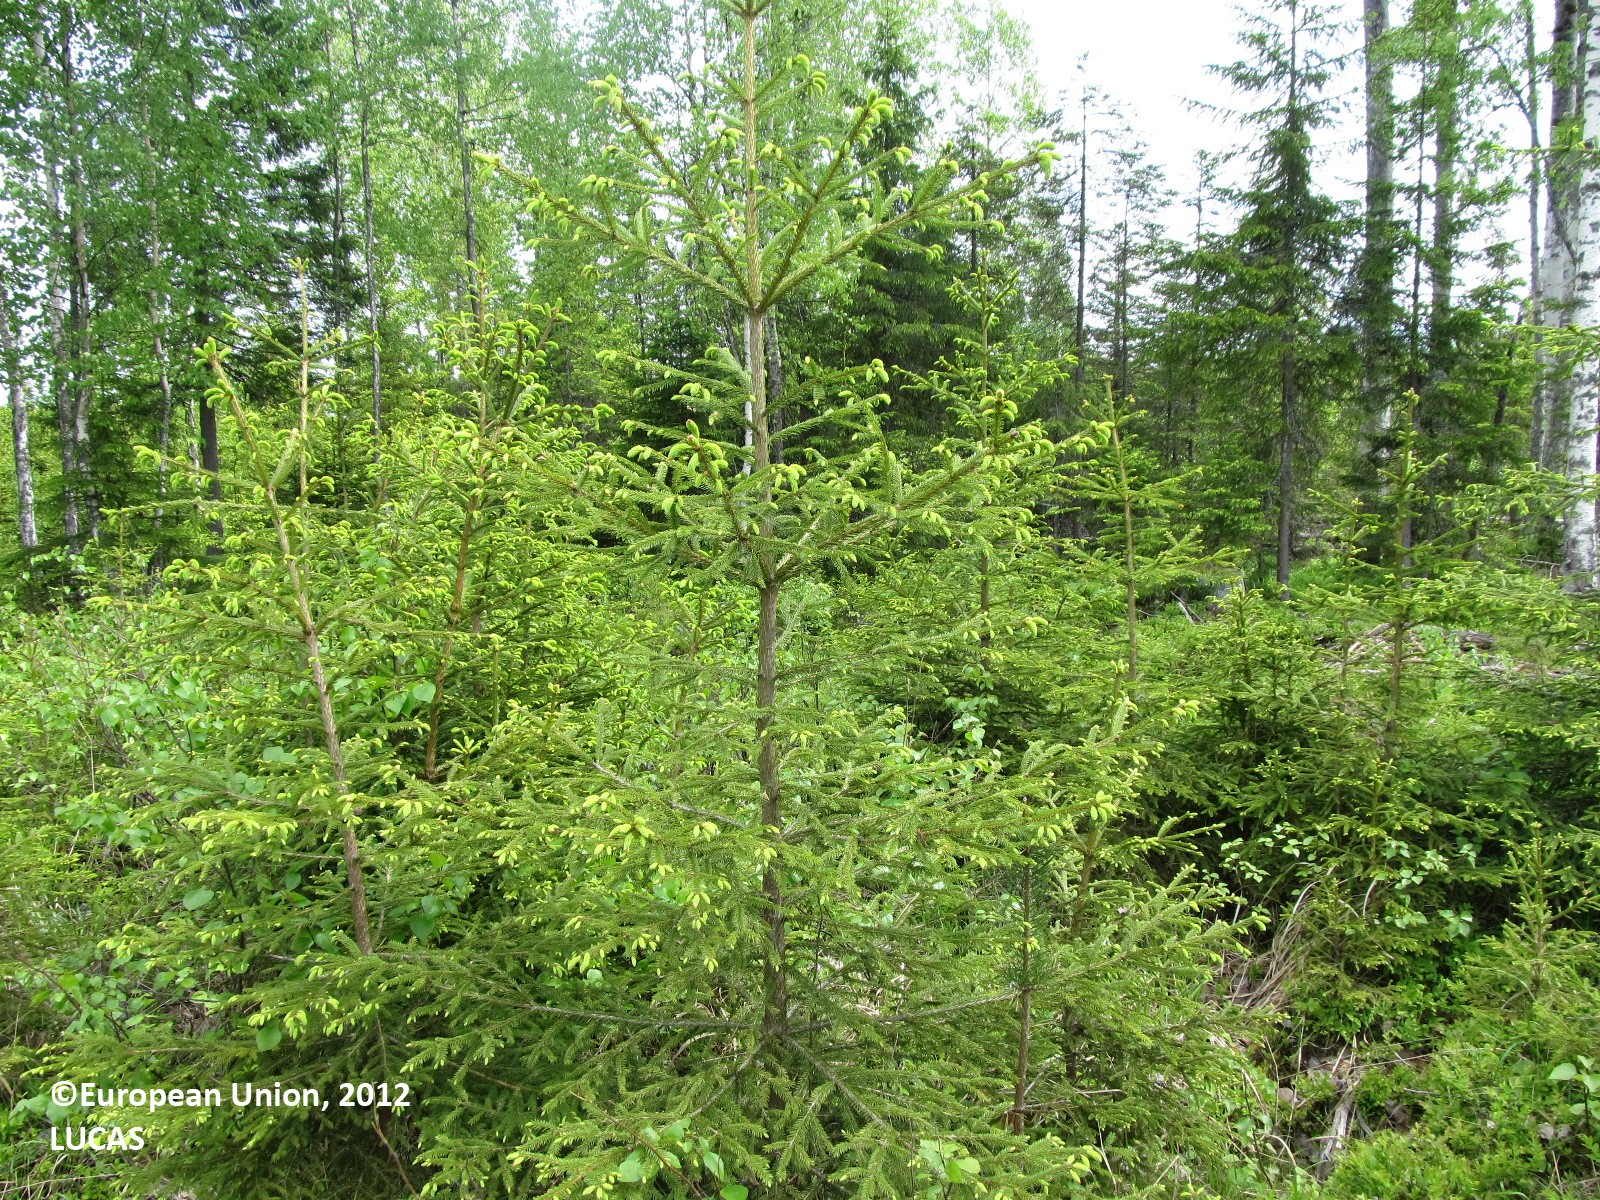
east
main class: Woodland
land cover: Spruce dominated coniferous woodland
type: boreal forest
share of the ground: 25 - 50 %
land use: Forestry
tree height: < 5 m
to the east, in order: Spruce dominated coniferous woodland; Other bare soil; Spruce dominated coniferous woodland; Other bare soil; Broadleaved woodland; Spruce dominated coniferous woodland; Other bare soil; Spruce dominated coniferous woodland
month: June
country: FI
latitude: 62.5795
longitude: 28.8402
